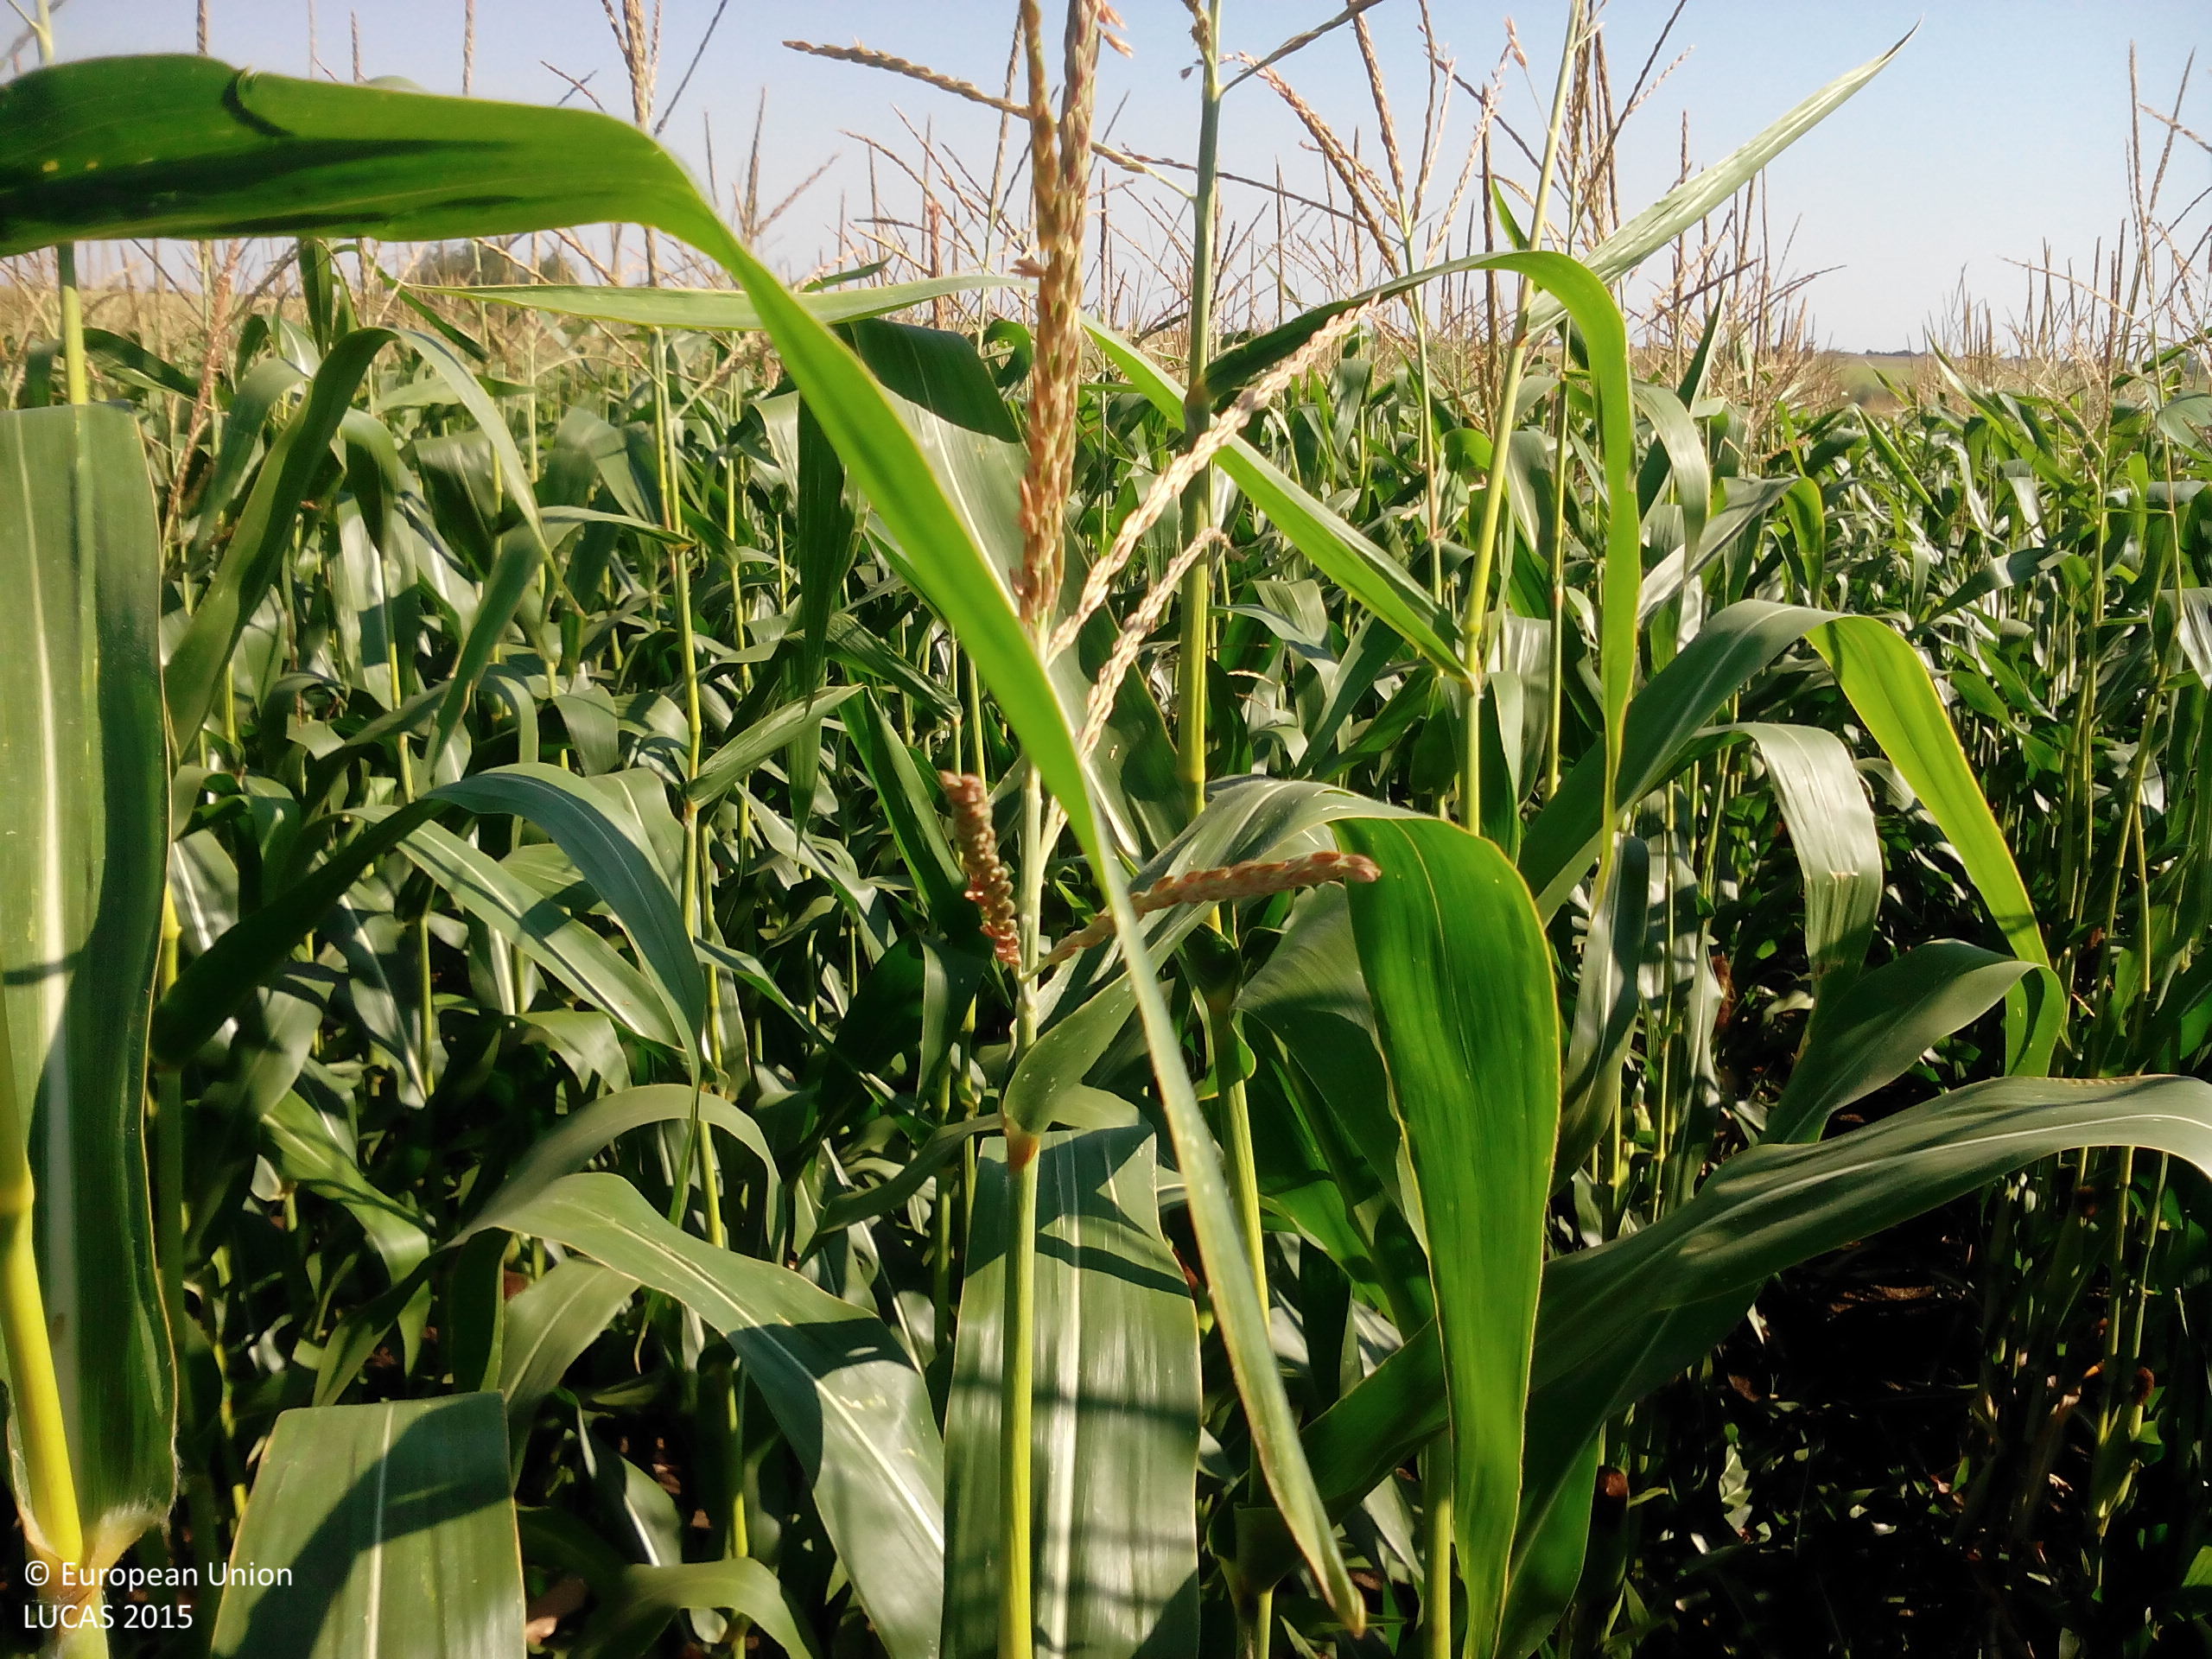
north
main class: Cropland
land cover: Maize
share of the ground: > 75 %
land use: Agriculture (excluding fallow land and kitchen gardens)
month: July
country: BG
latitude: 43.4028
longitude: 24.3441
